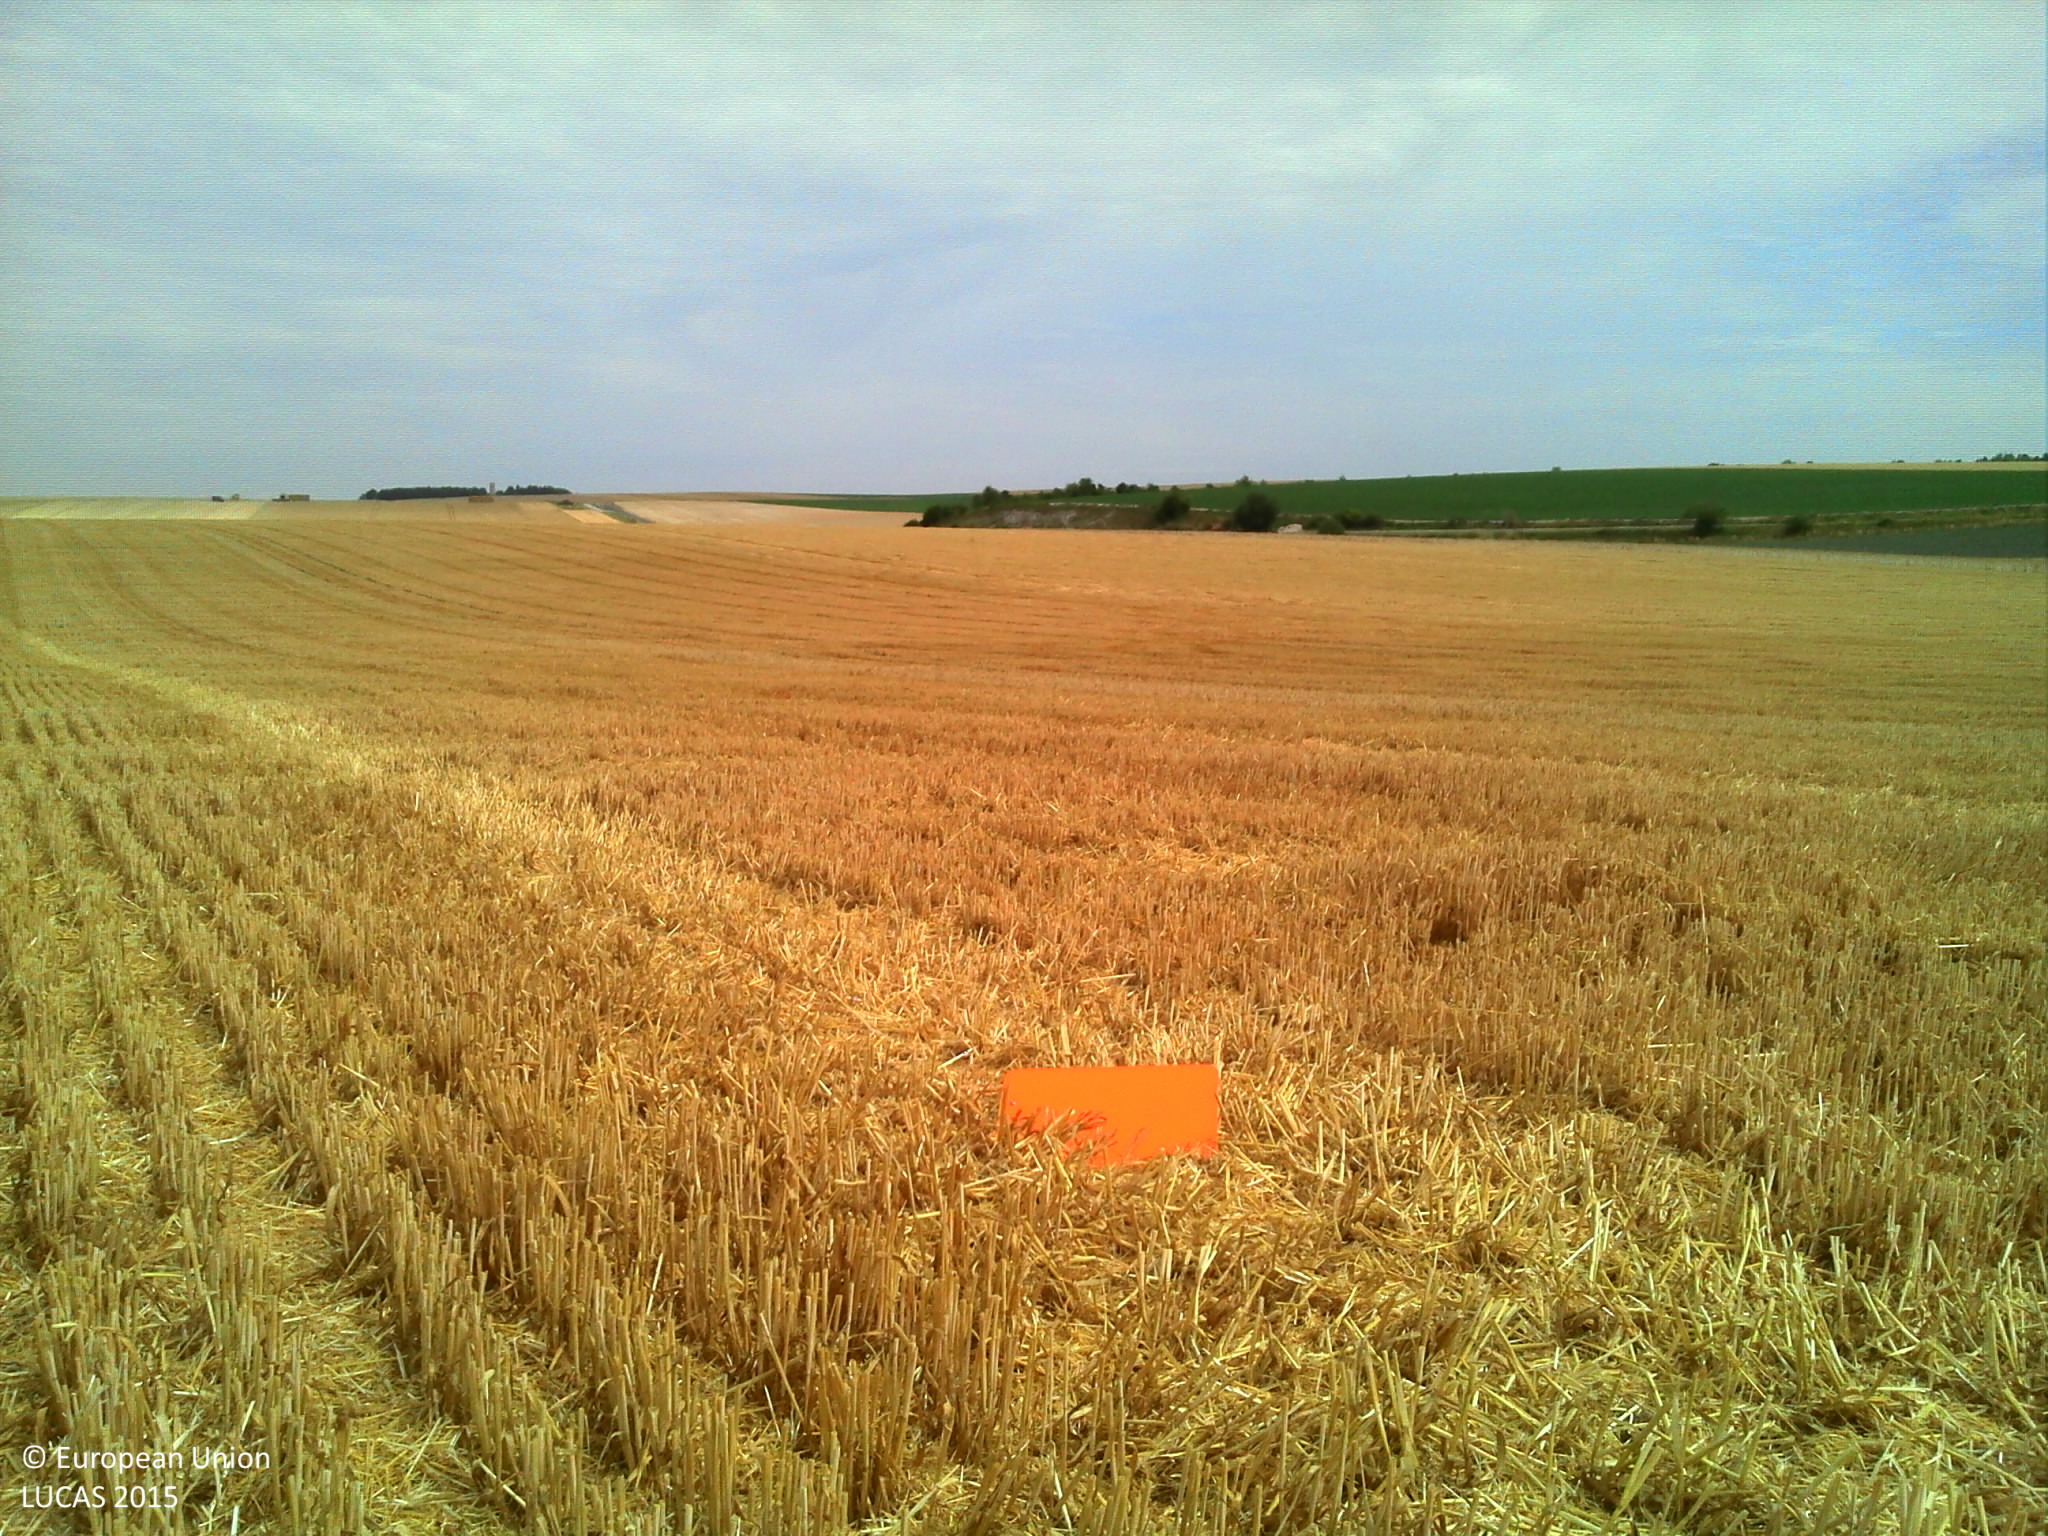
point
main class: Cropland
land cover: Barley
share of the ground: > 75 %
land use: Agriculture (excluding fallow land and kitchen gardens)
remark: Harvested field
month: July
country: FR
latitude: 49.2604
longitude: 4.5414
